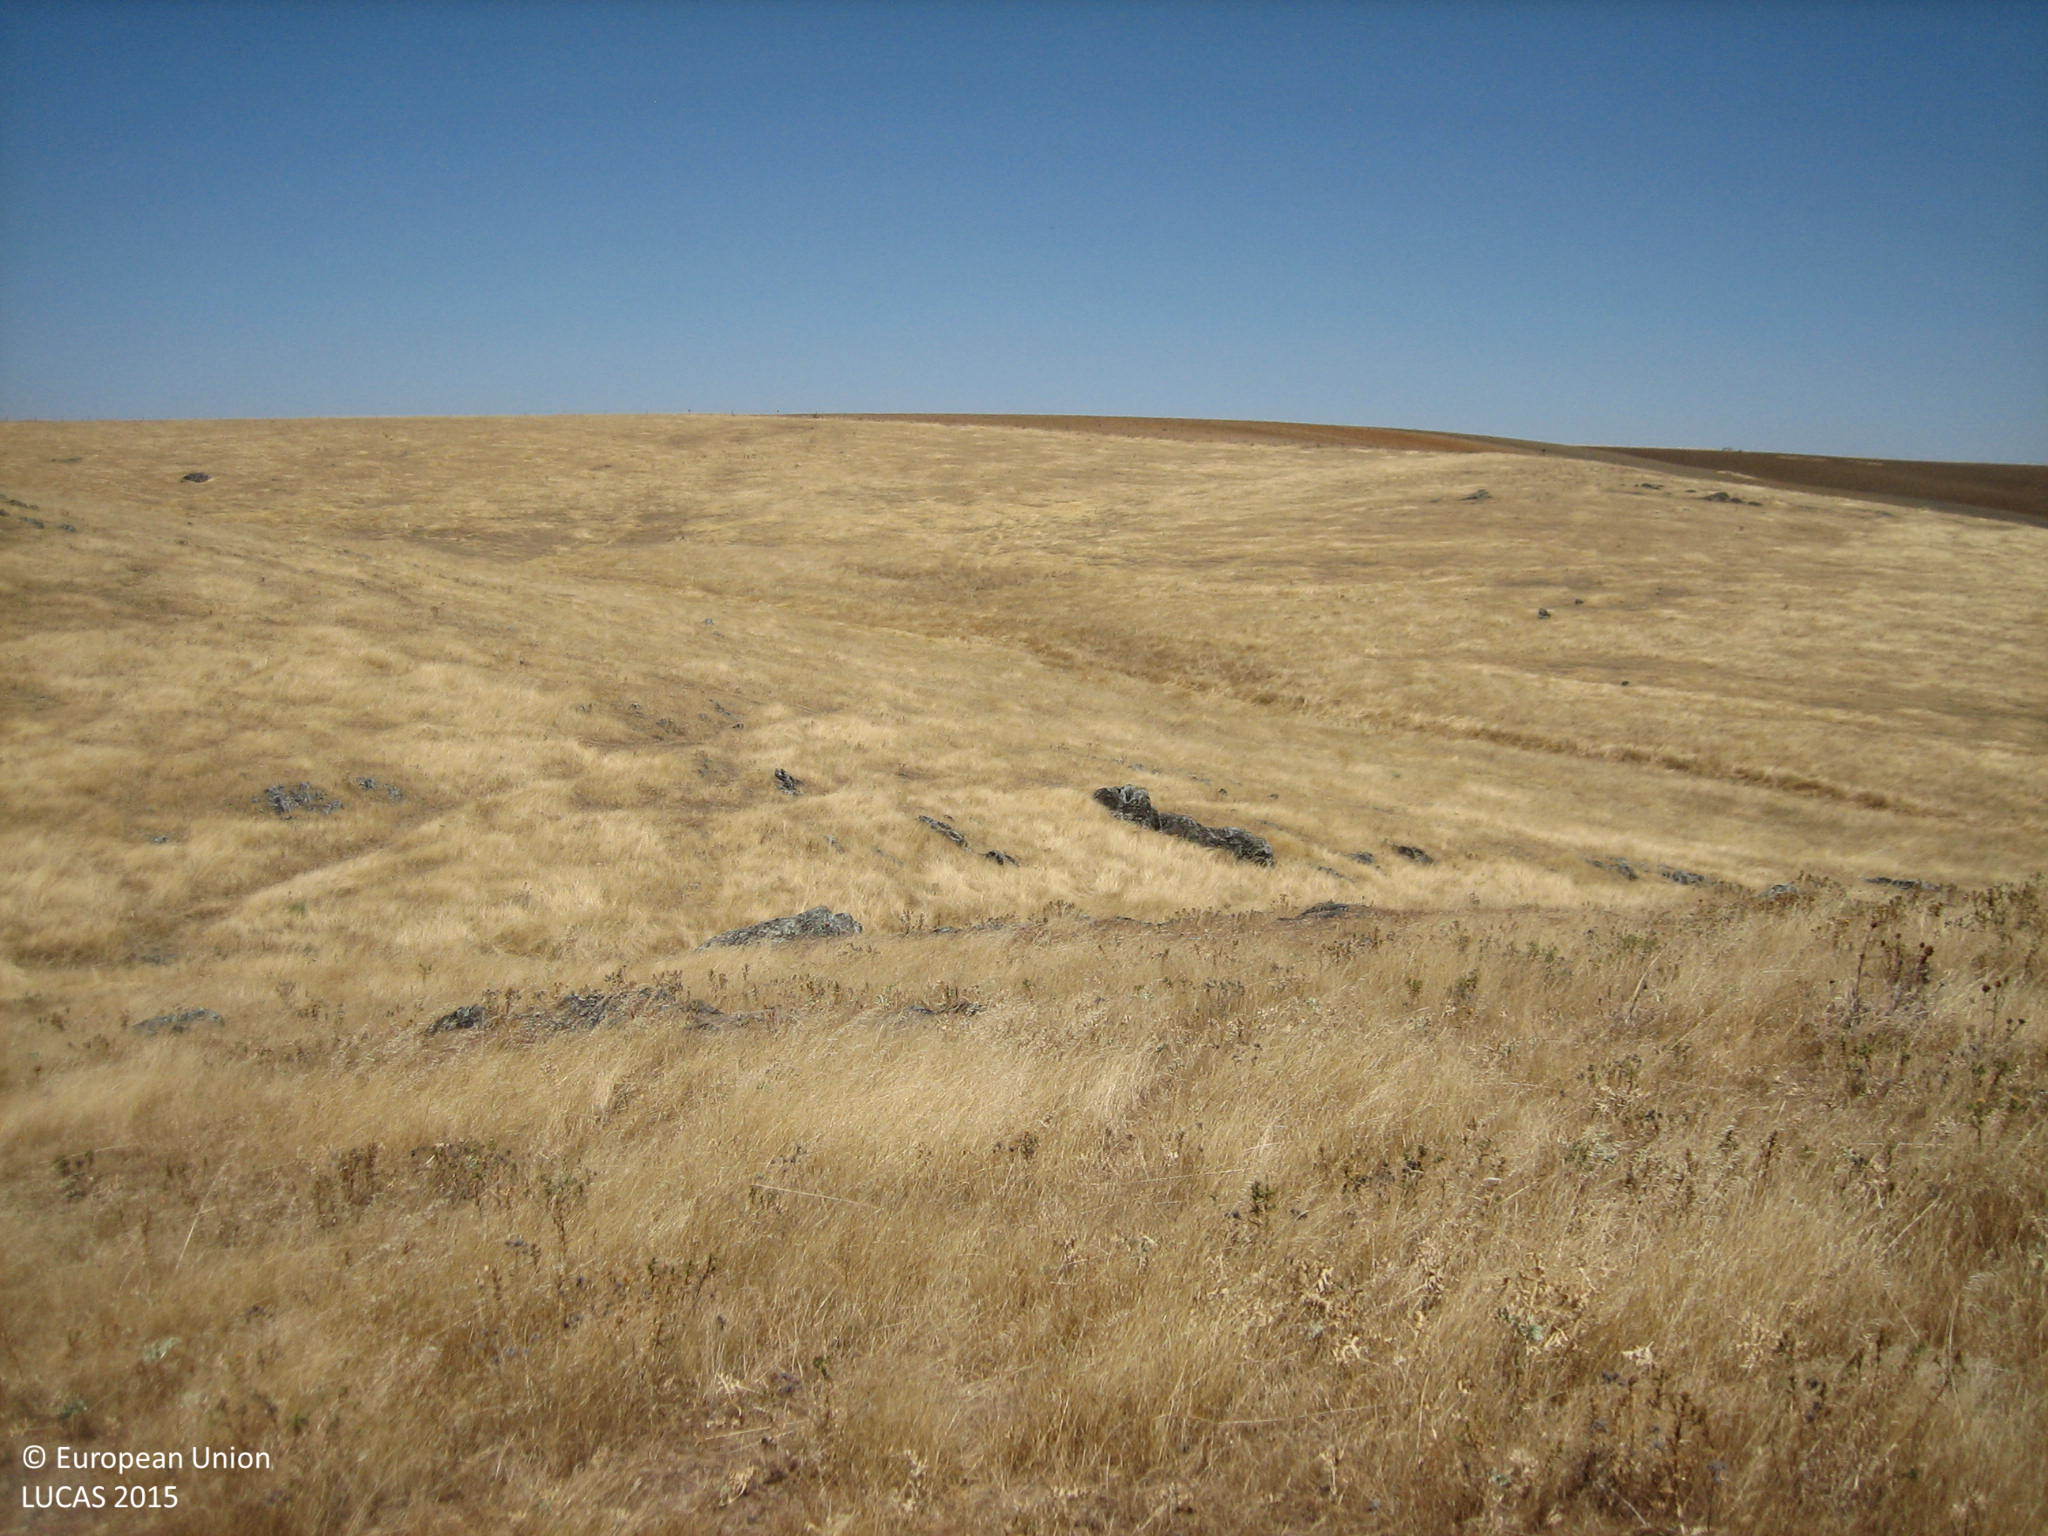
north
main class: Grassland
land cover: Grassland without tree/shrub cover
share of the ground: > 75 %
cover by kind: herbaceous plants 100 %
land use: Agriculture (excluding fallow land and kitchen gardens)
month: July
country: ES
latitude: 38.1989
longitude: -6.2698
